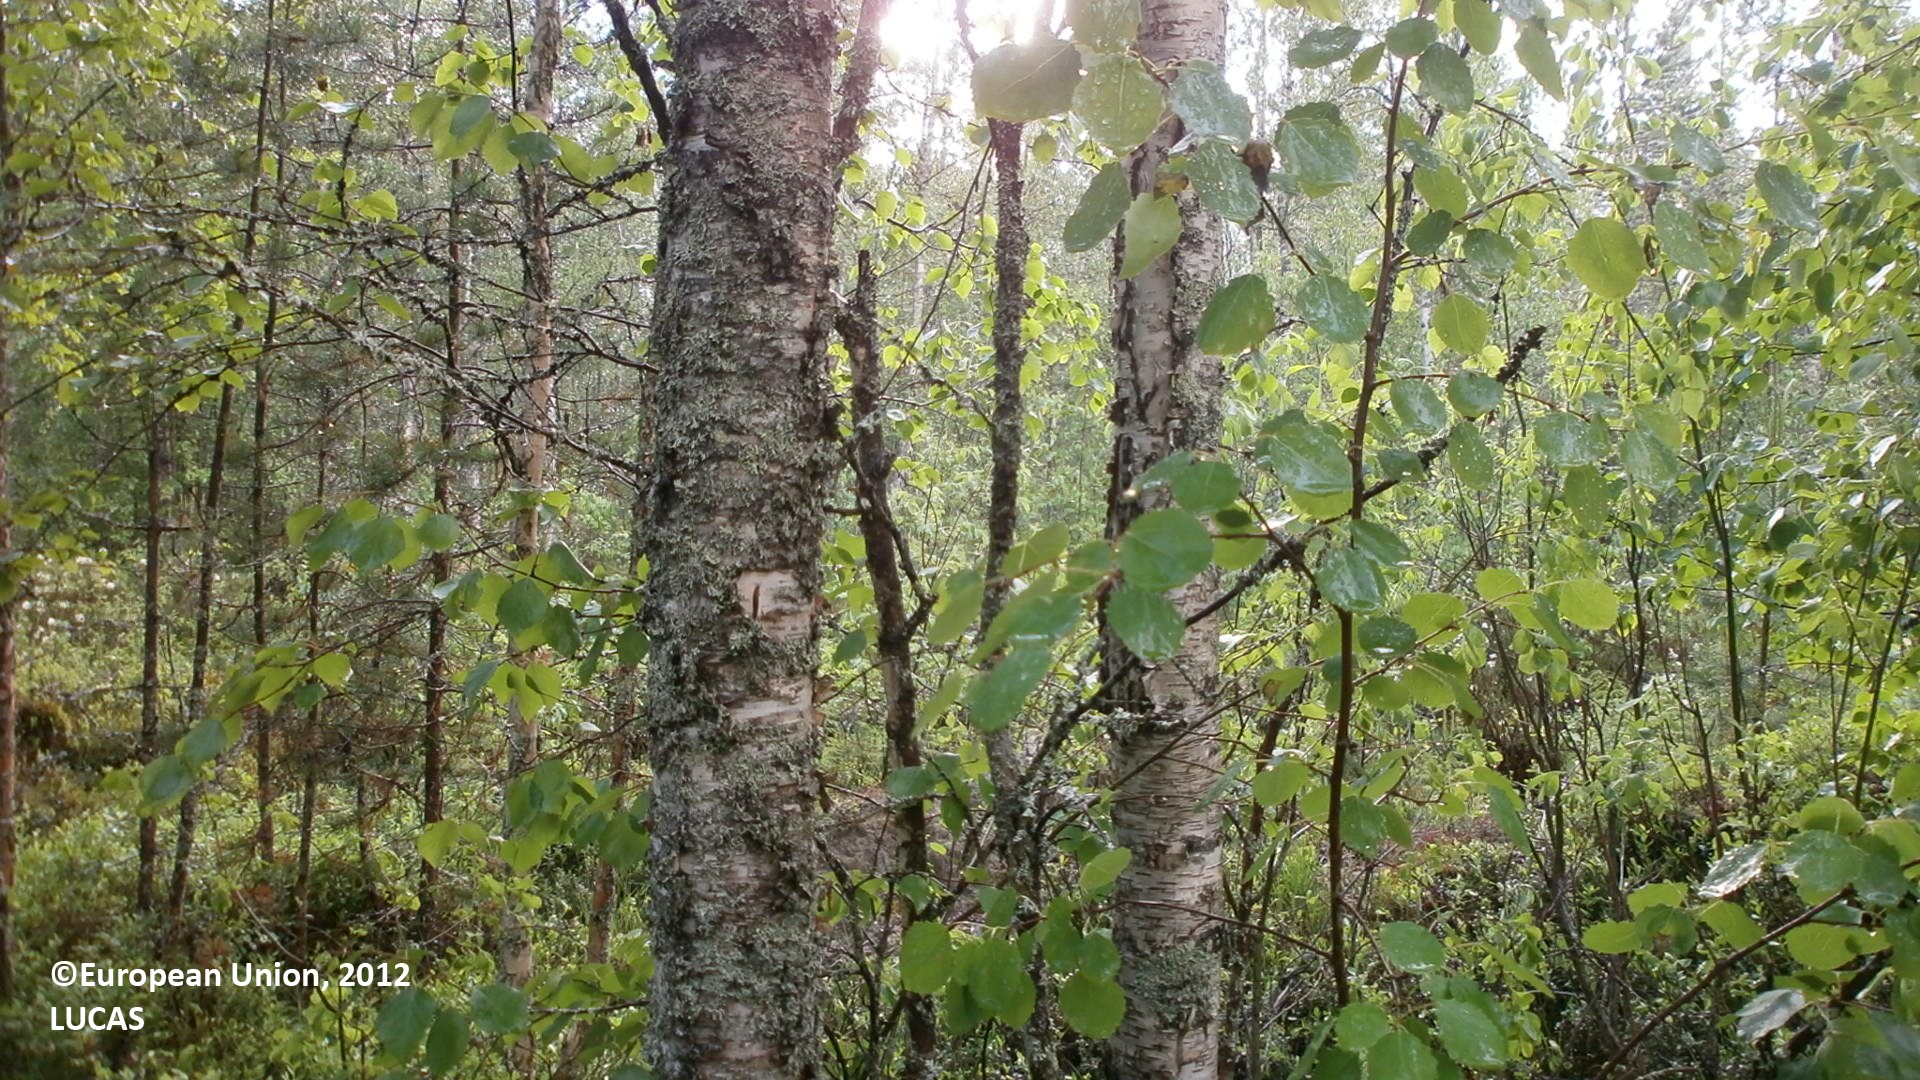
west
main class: Woodland
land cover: Broadleaved woodland
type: boreal forest
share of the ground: > 75 %
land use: Forestry
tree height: > 5 m
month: June
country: FI
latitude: 64.7861
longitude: 25.2068
